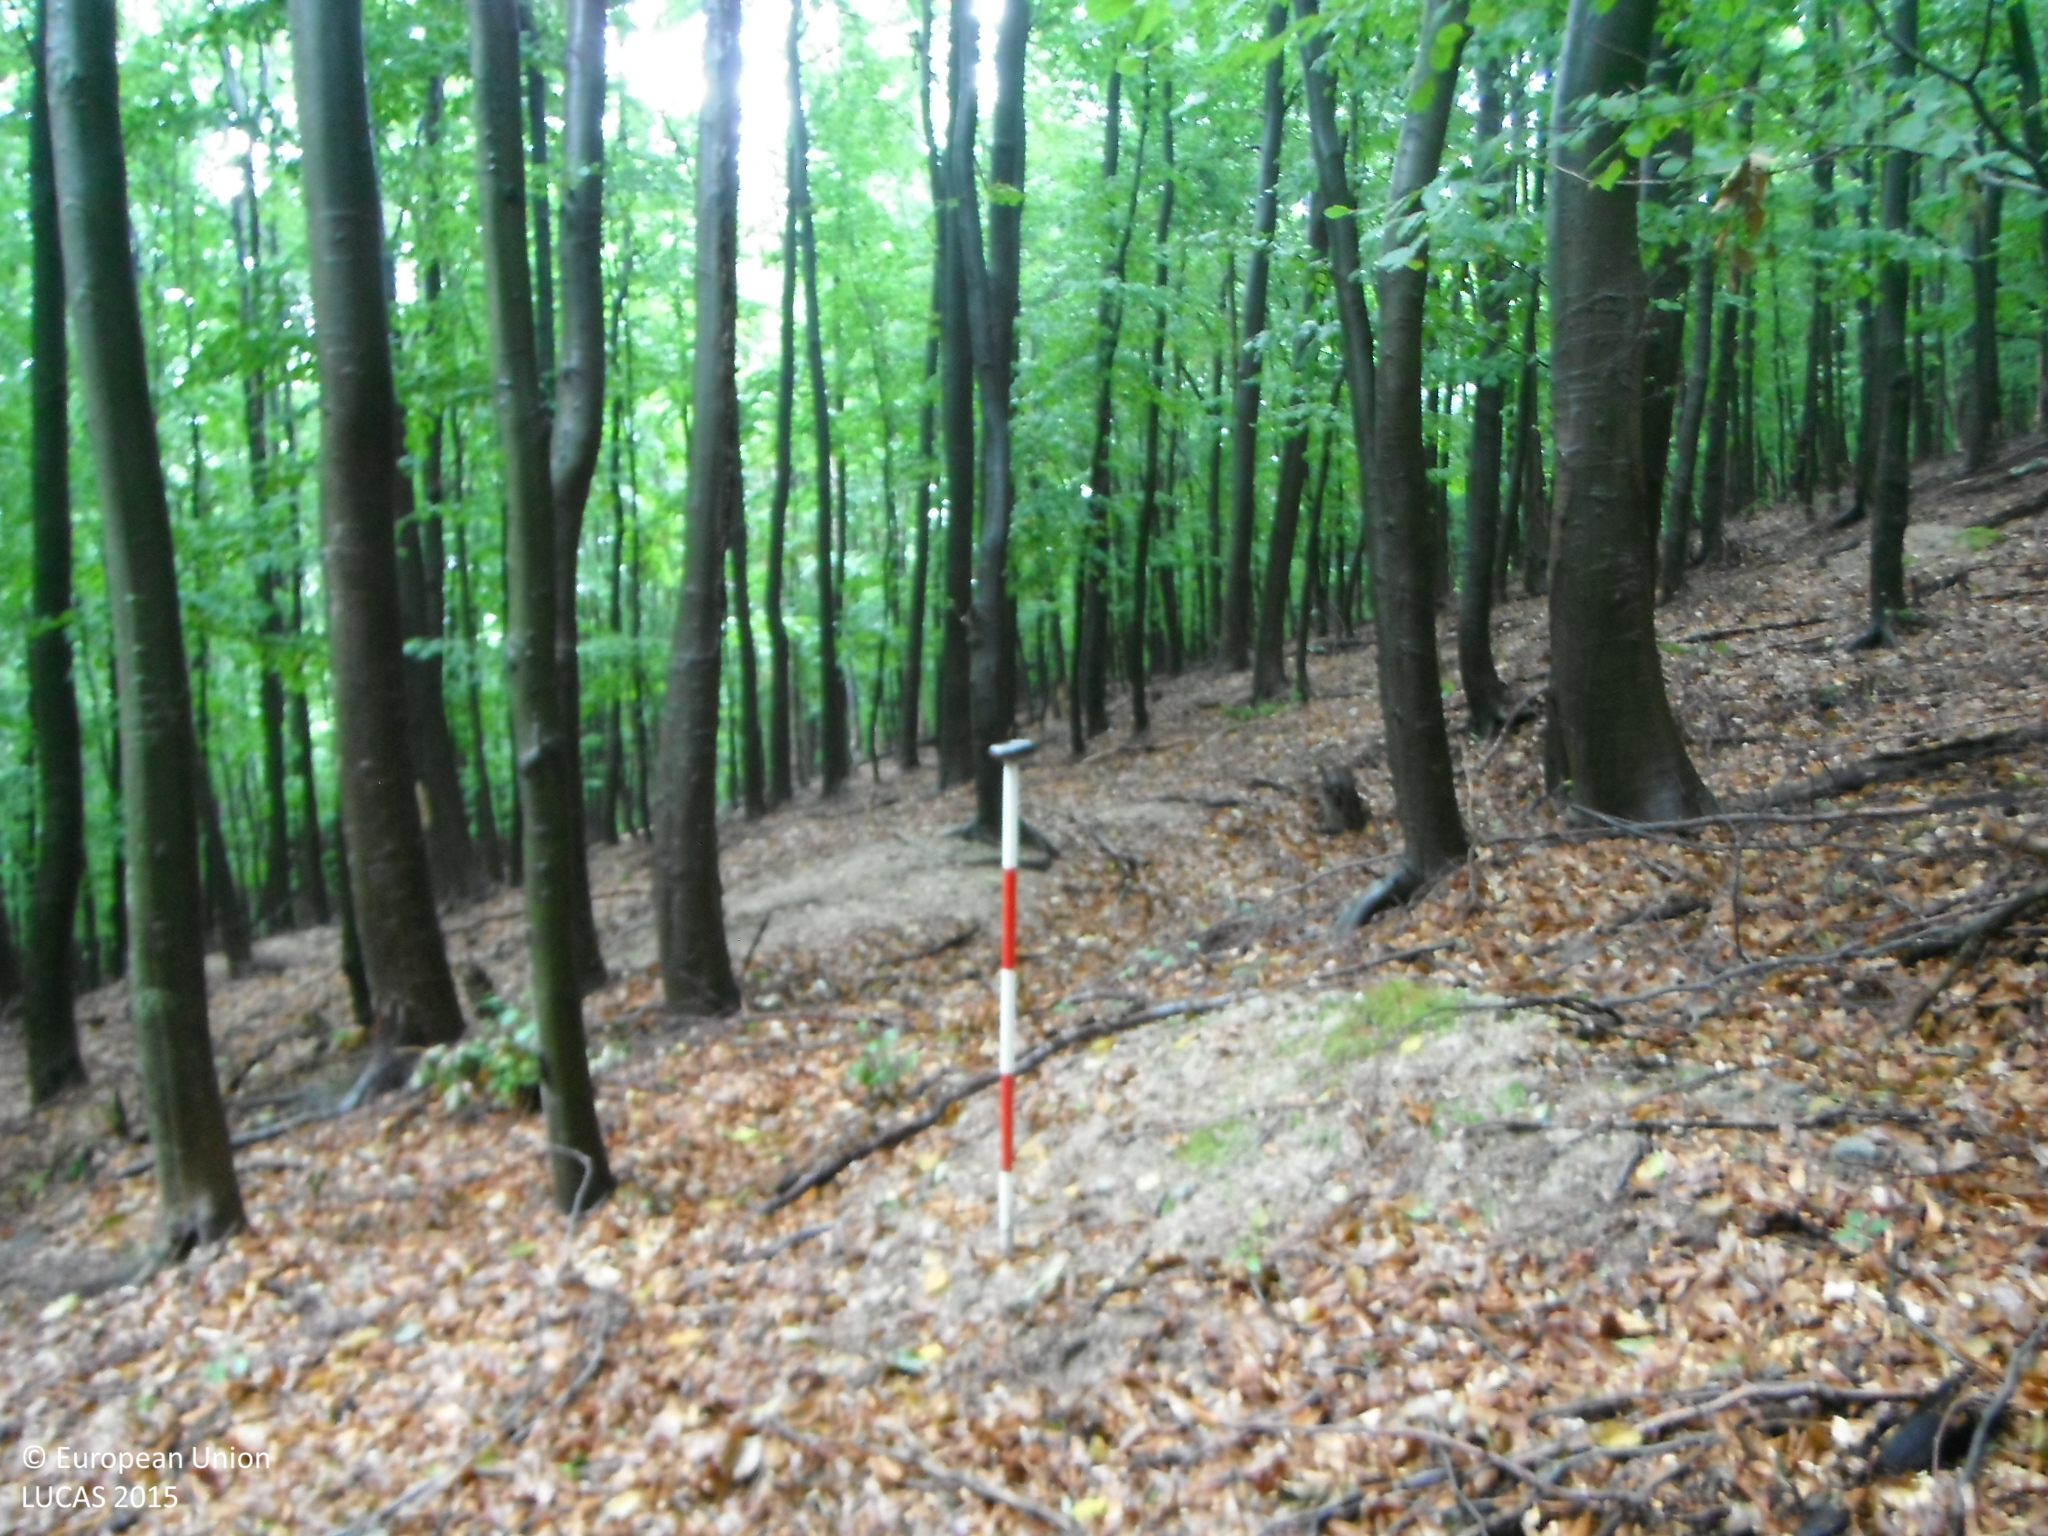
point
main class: Woodland
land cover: Broadleaved woodland
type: beech forest
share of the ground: > 75 %
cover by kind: broadleaved forest trees 100 %
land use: Forestry
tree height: > 5 m
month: August
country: SK
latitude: 48.8183
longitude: 18.7218
